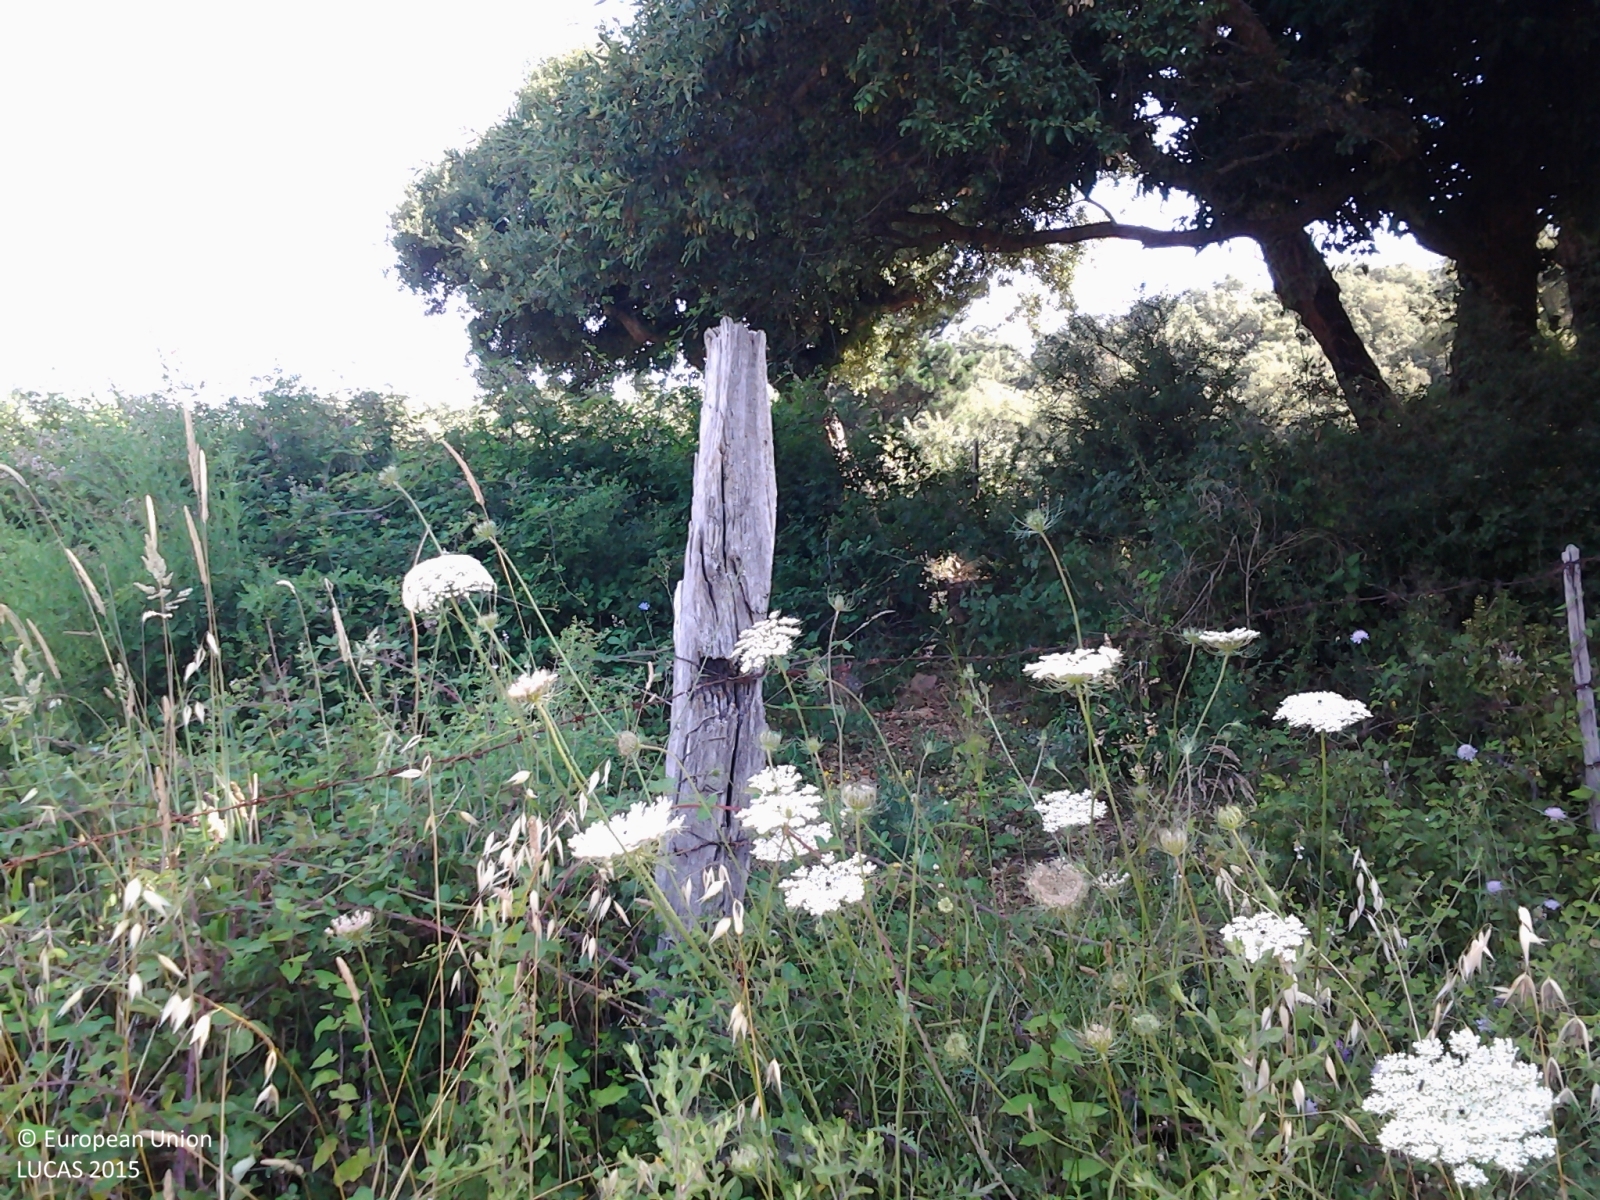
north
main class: Woodland
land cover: Broadleaved woodland
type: broadleaved evergreen forest
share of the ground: > 75 %
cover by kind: broadleaved forest trees 90 %, shrubs 5 %, herbaceous plants 5 %
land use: Semi-natural and natural areas not in use
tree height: > 5 m
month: July
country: IT
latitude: 37.9698
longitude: 14.4657
